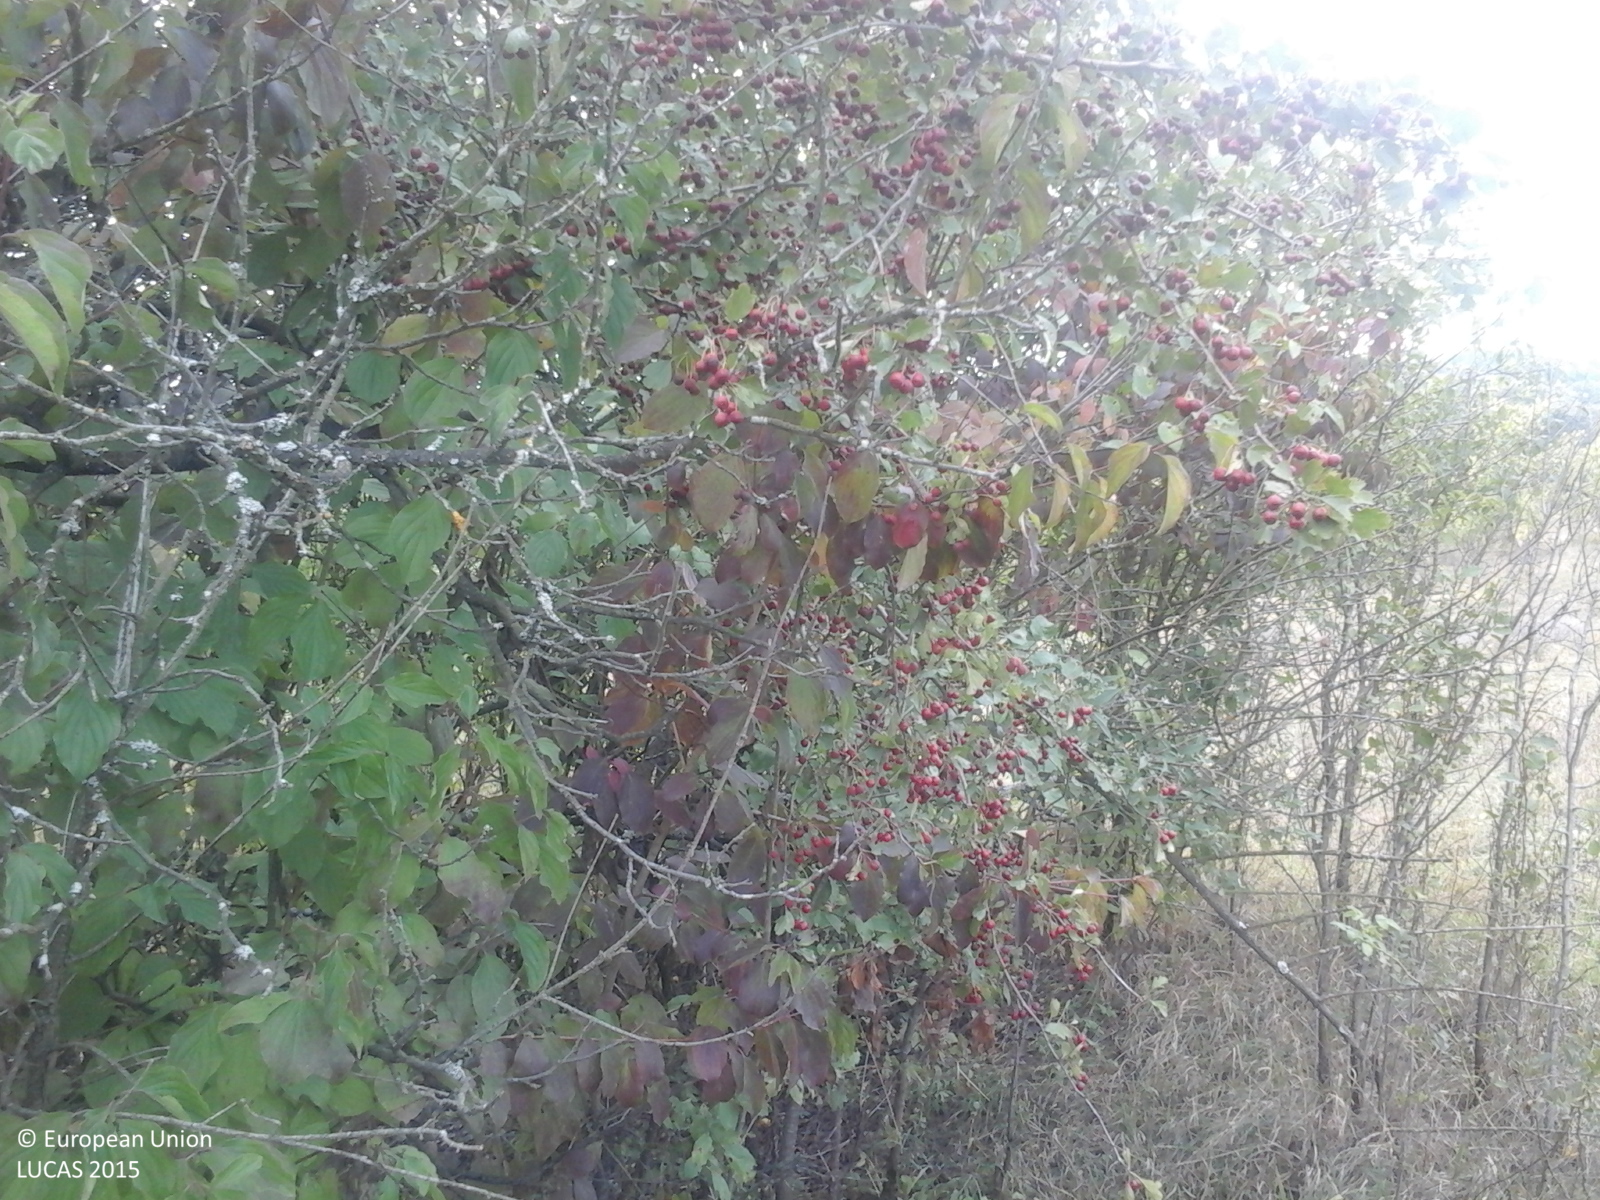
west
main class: Shrubland
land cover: Shrubland with sparse tree cover
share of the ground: > 75 %
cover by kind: shrubs 75 %, herbaceous plants 20 %, broadleaved forest trees 5 %
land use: Fallow land
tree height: > 5 m
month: September
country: RO
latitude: 45.8086
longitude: 22.8565
